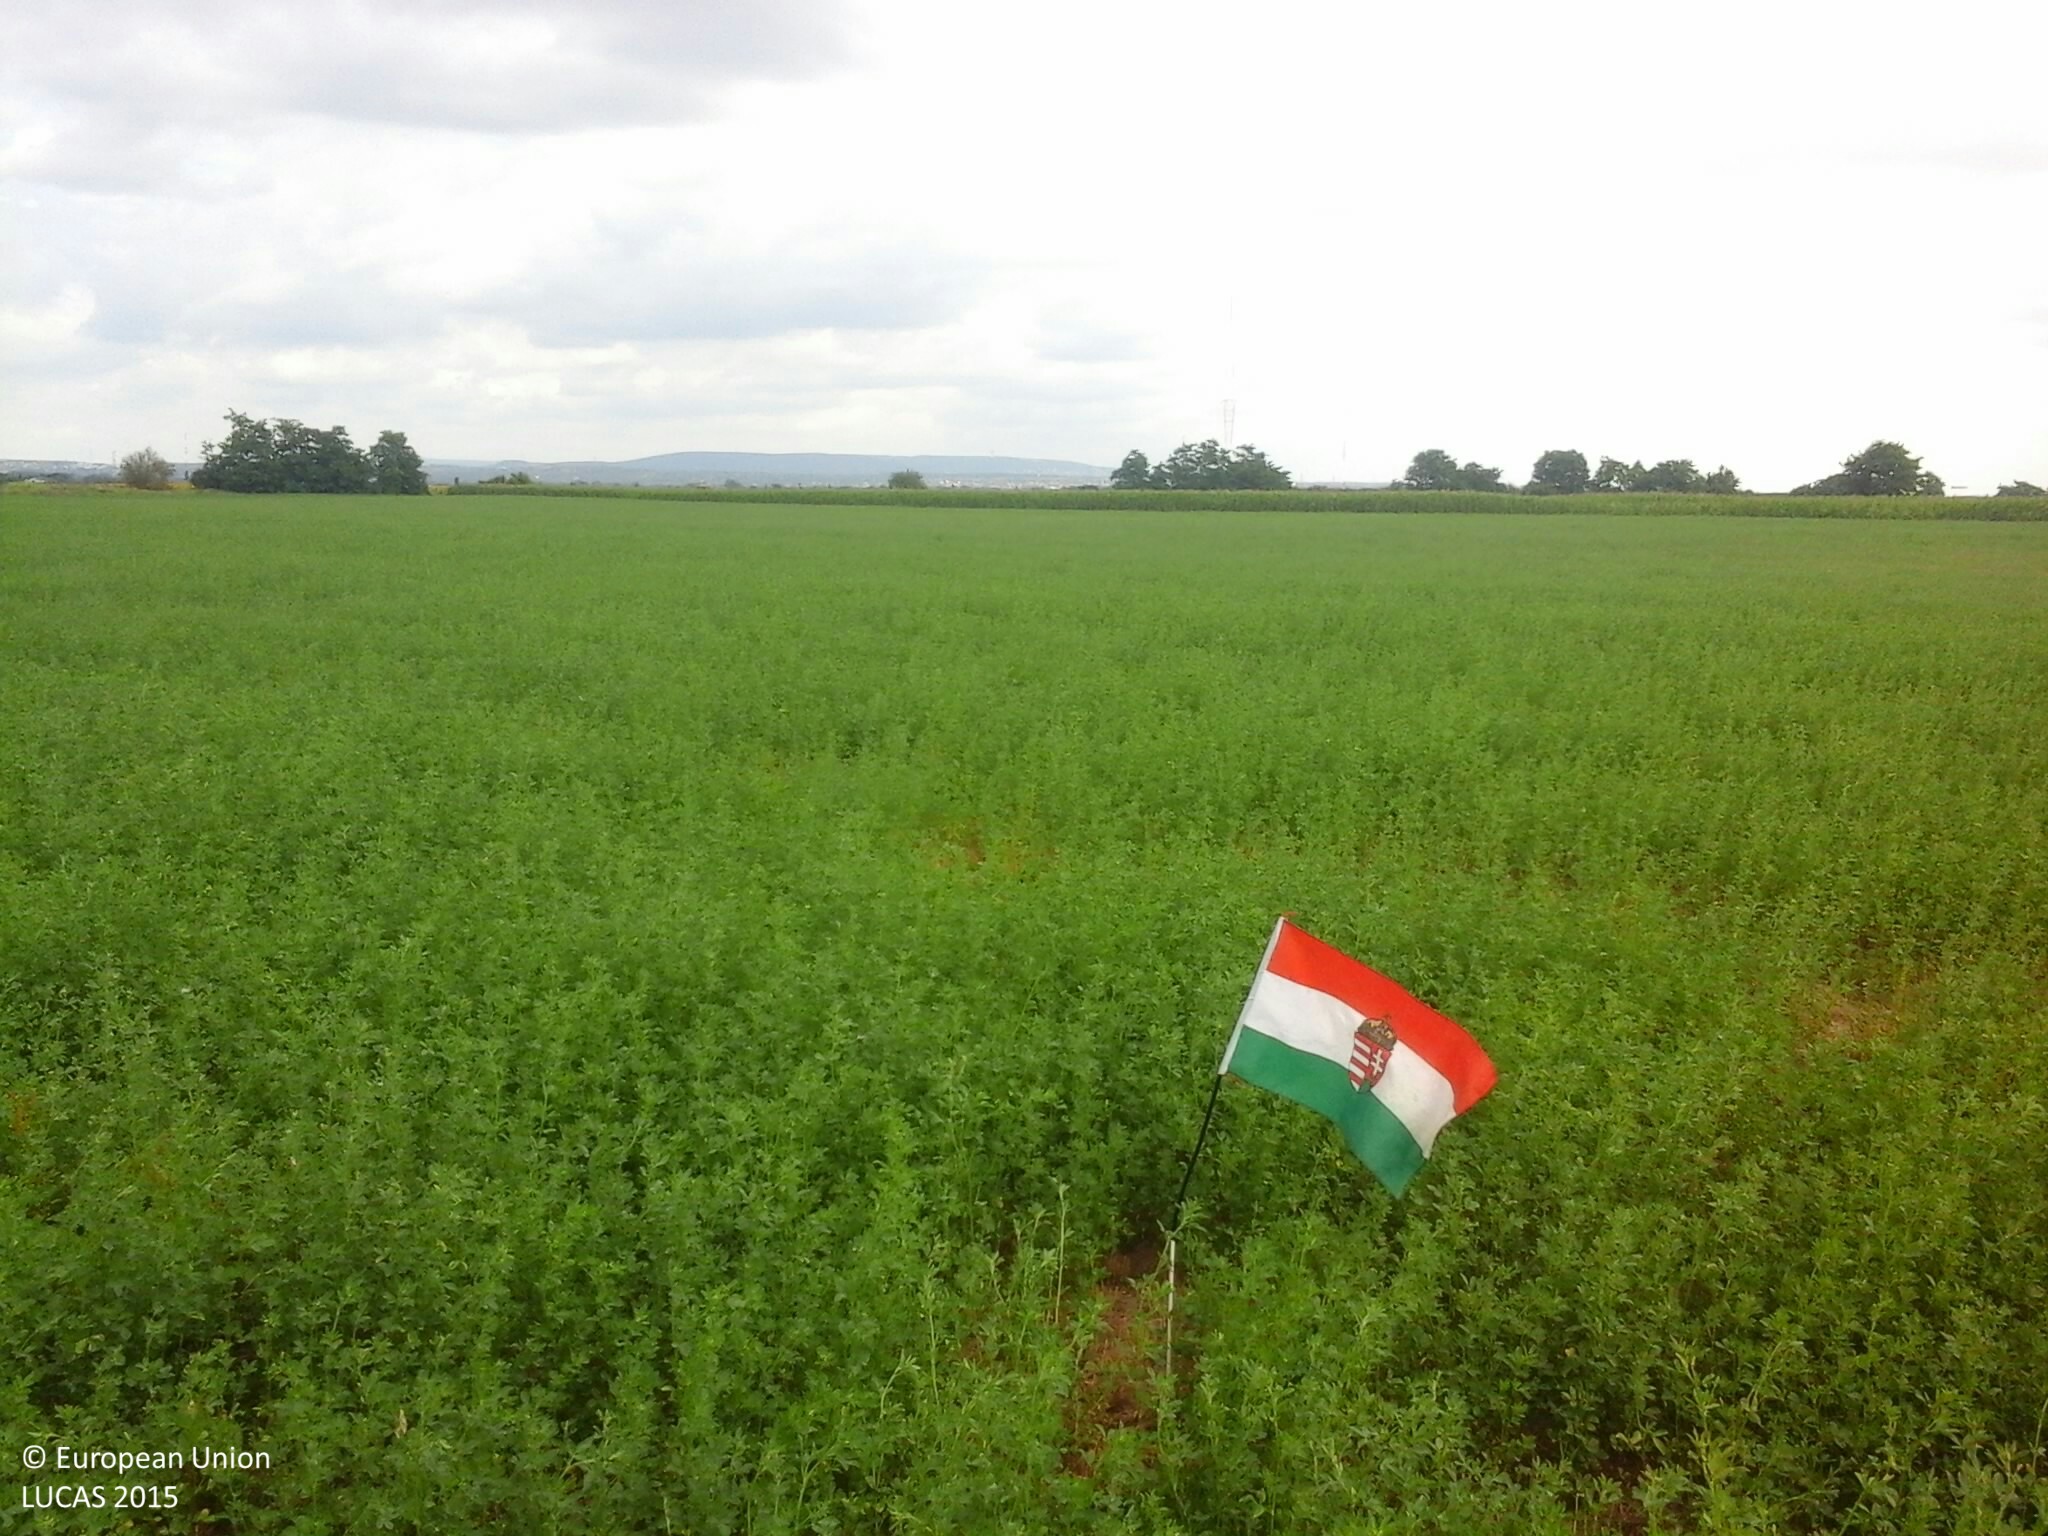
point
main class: Cropland
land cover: Lucerne
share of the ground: > 75 %
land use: Agriculture (excluding fallow land and kitchen gardens)
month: July
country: HU
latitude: 47.3474
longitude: 19.0048
